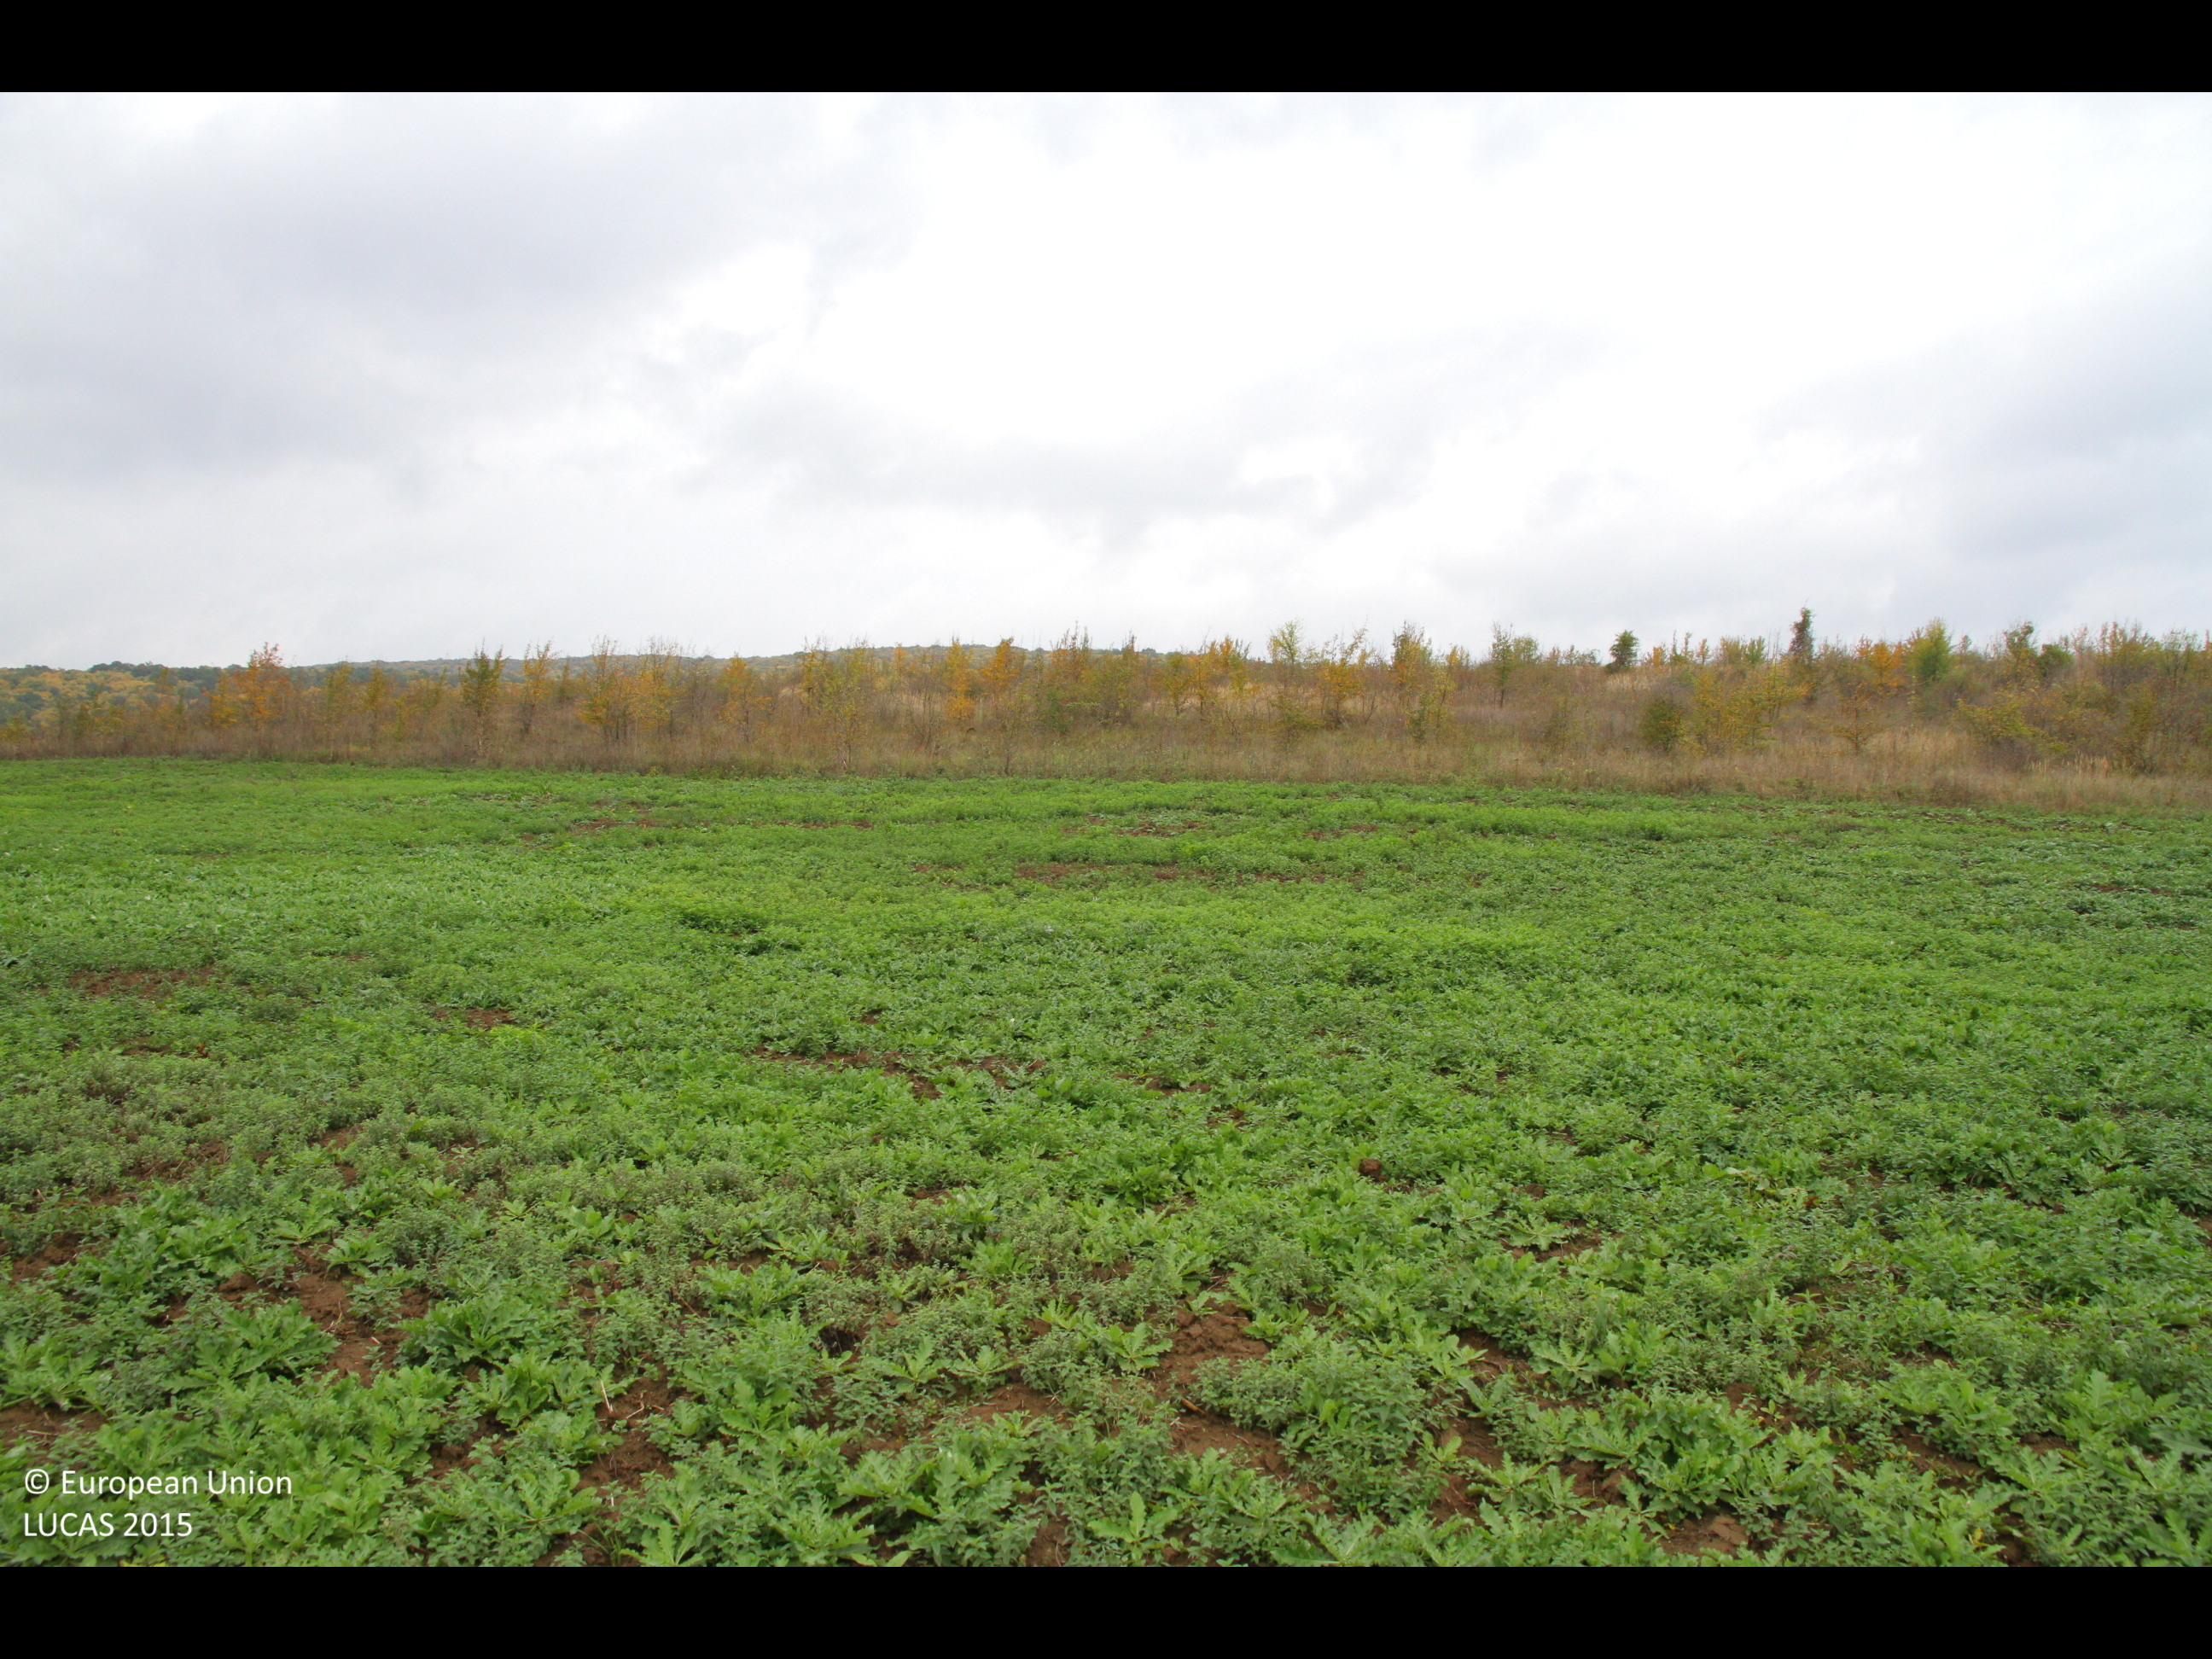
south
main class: Grassland
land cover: Spontaneously vegetated surfaces
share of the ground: > 75 %
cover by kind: herbaceous plants 100 %
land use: Agriculture (excluding fallow land and kitchen gardens)
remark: Harvested field
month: October
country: BG
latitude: 43.1617
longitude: 27.0756
